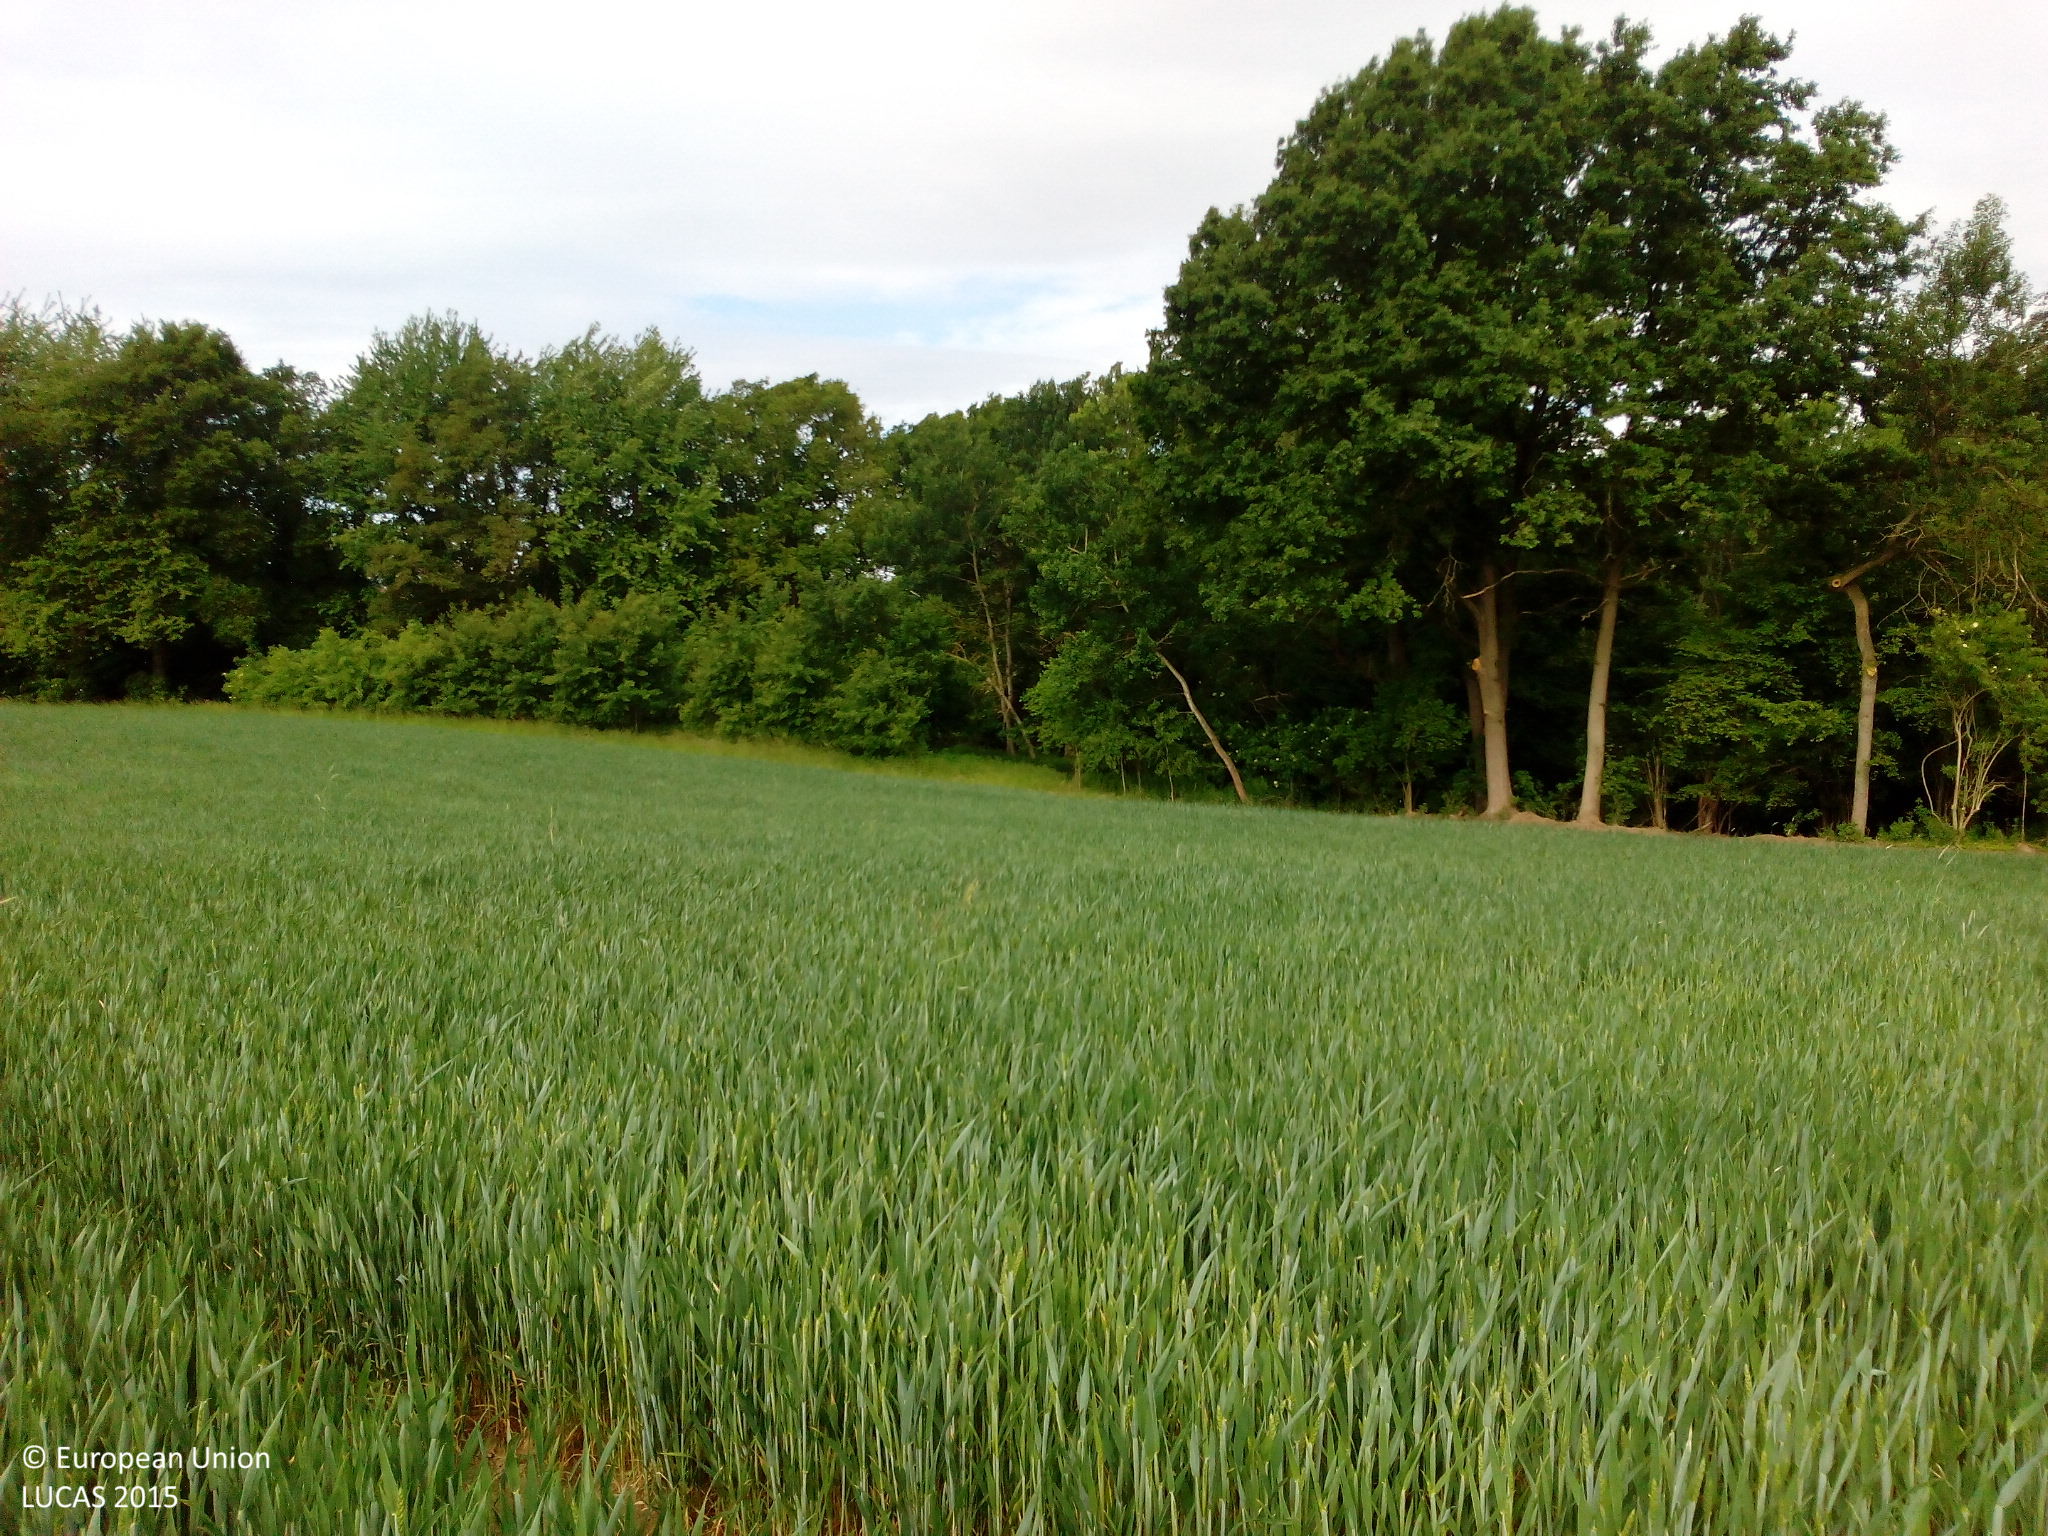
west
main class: Cropland
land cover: Common wheat
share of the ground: > 75 %
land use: Agriculture (excluding fallow land and kitchen gardens)
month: June
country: DE
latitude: 51.5340
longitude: 8.0253
